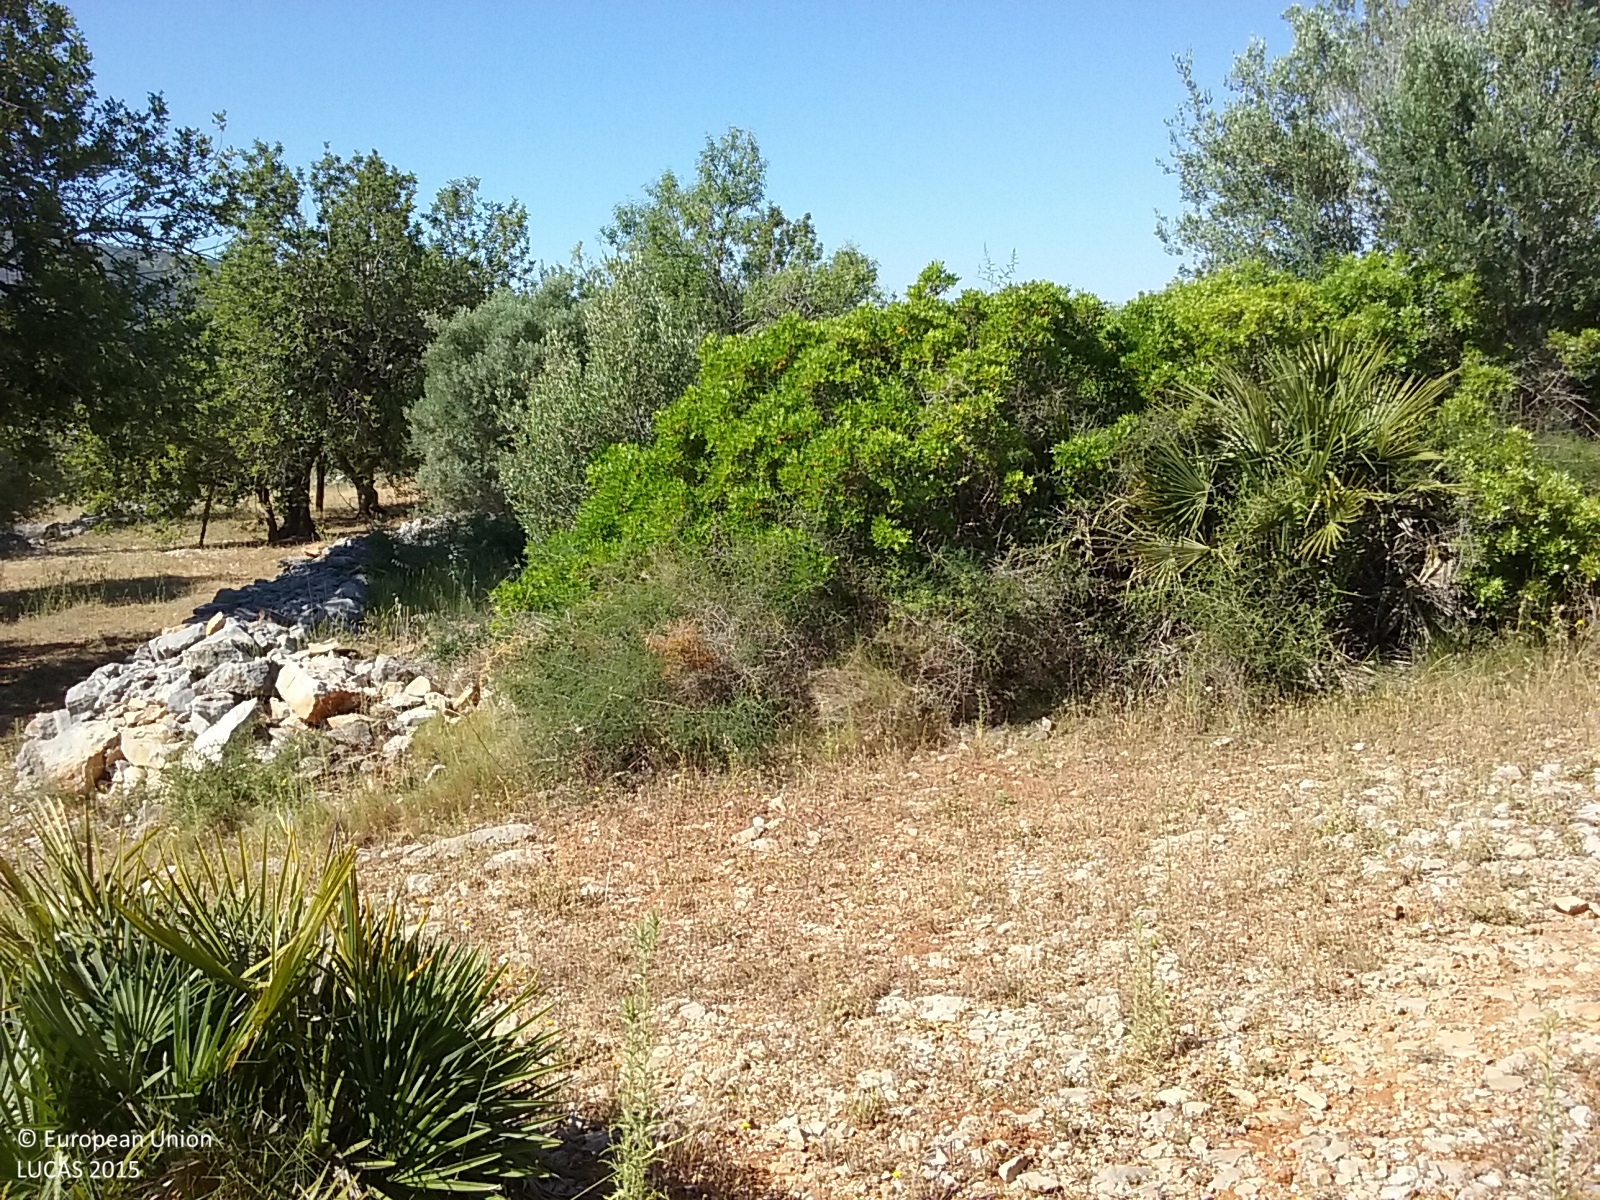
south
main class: Shrubland
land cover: Shrubland with sparse tree cover
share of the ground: > 75 %
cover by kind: shrubs 75 %, herbaceous plants 10 %, broadleaved forest trees 5 %
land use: Semi-natural and natural areas not in use
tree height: < 5 m
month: May
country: ES
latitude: 40.3687
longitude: 0.3045
